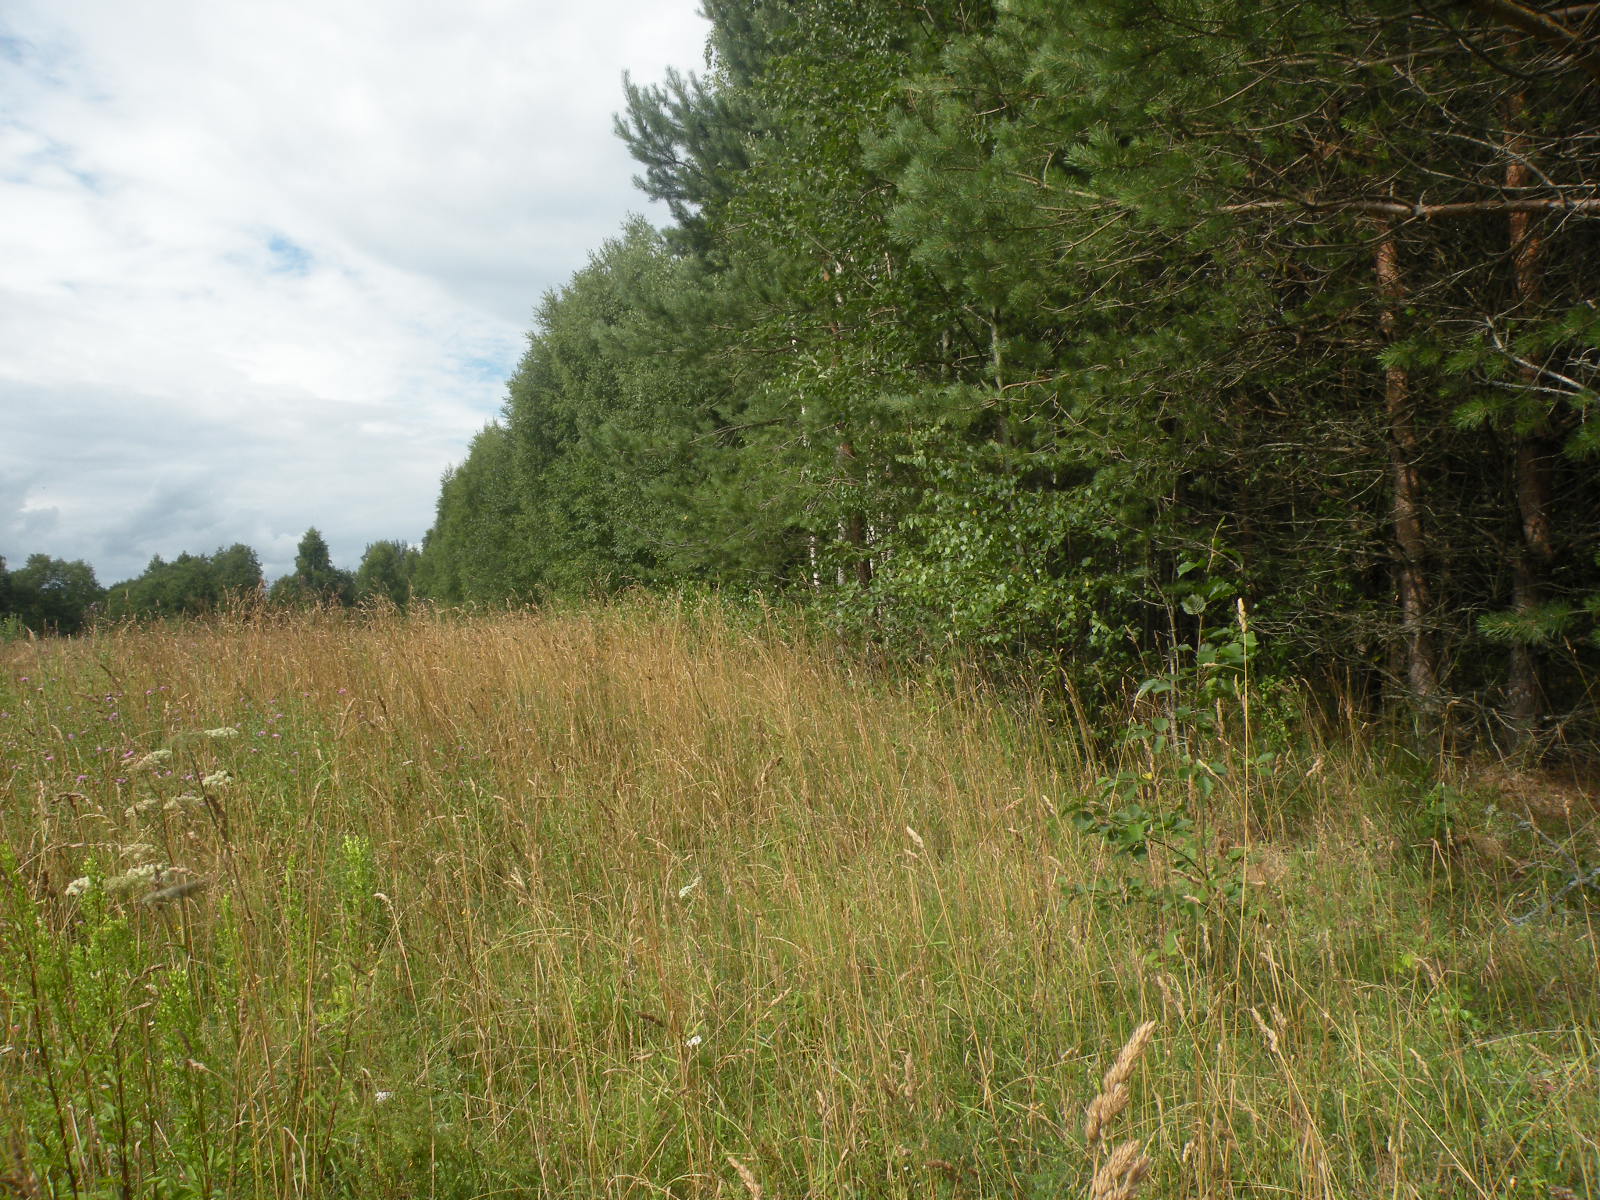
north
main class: Grassland
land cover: Grassland with sparse tree/shrub cover
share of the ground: > 75 %
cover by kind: herbaceous plants 85 %, shrubs 10 %, coniferous forest trees 5 %
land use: Semi-natural and natural areas not in use
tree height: < 5 m
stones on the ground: < 10 %
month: July
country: LV
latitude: 55.8225
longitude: 26.9399
